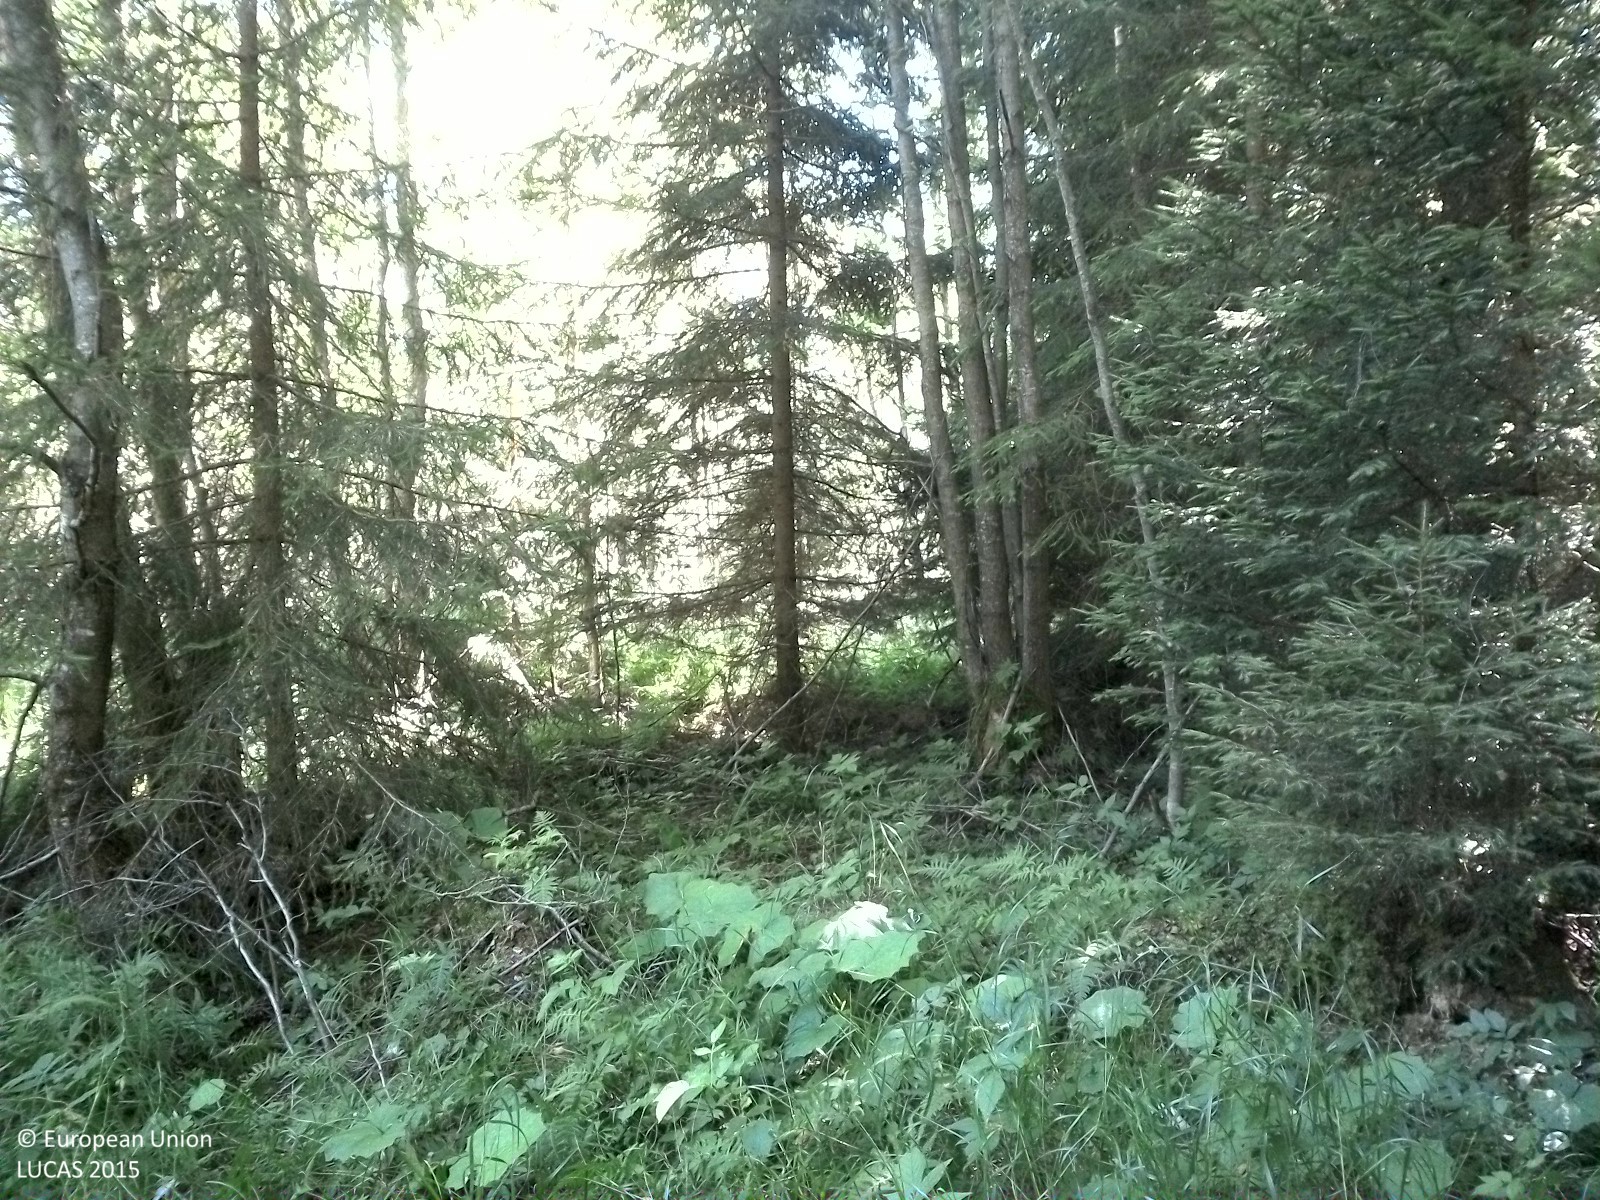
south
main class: Woodland
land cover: Spruce dominated mixed woodland
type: boreal forest
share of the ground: 50 - 75 %
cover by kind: shrubs 45 %, coniferous forest trees 30 %, broadleaved forest trees 25 %
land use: Forestry
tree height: > 5 m
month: August
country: SE
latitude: 59.2318
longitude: 14.8462
